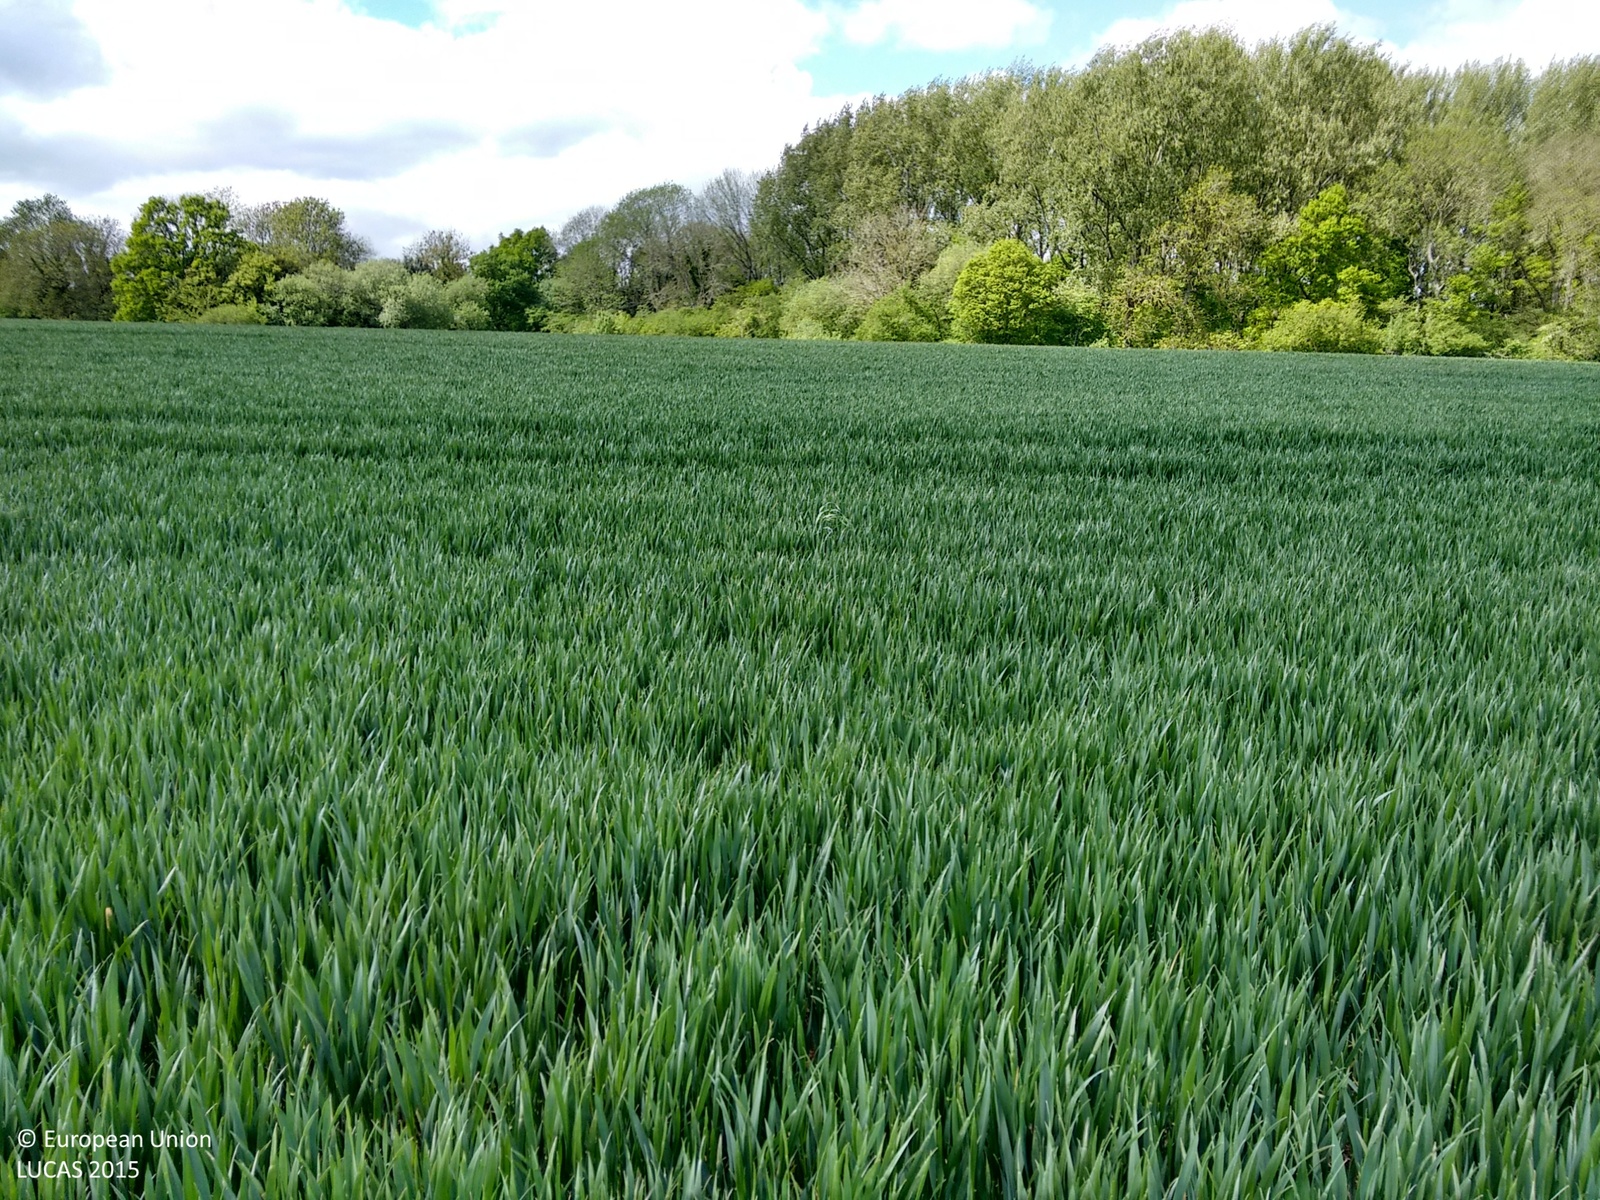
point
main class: Cropland
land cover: Common wheat
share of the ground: > 75 %
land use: Agriculture (excluding fallow land and kitchen gardens)
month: May
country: GB
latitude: 51.3194
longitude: -1.1960
